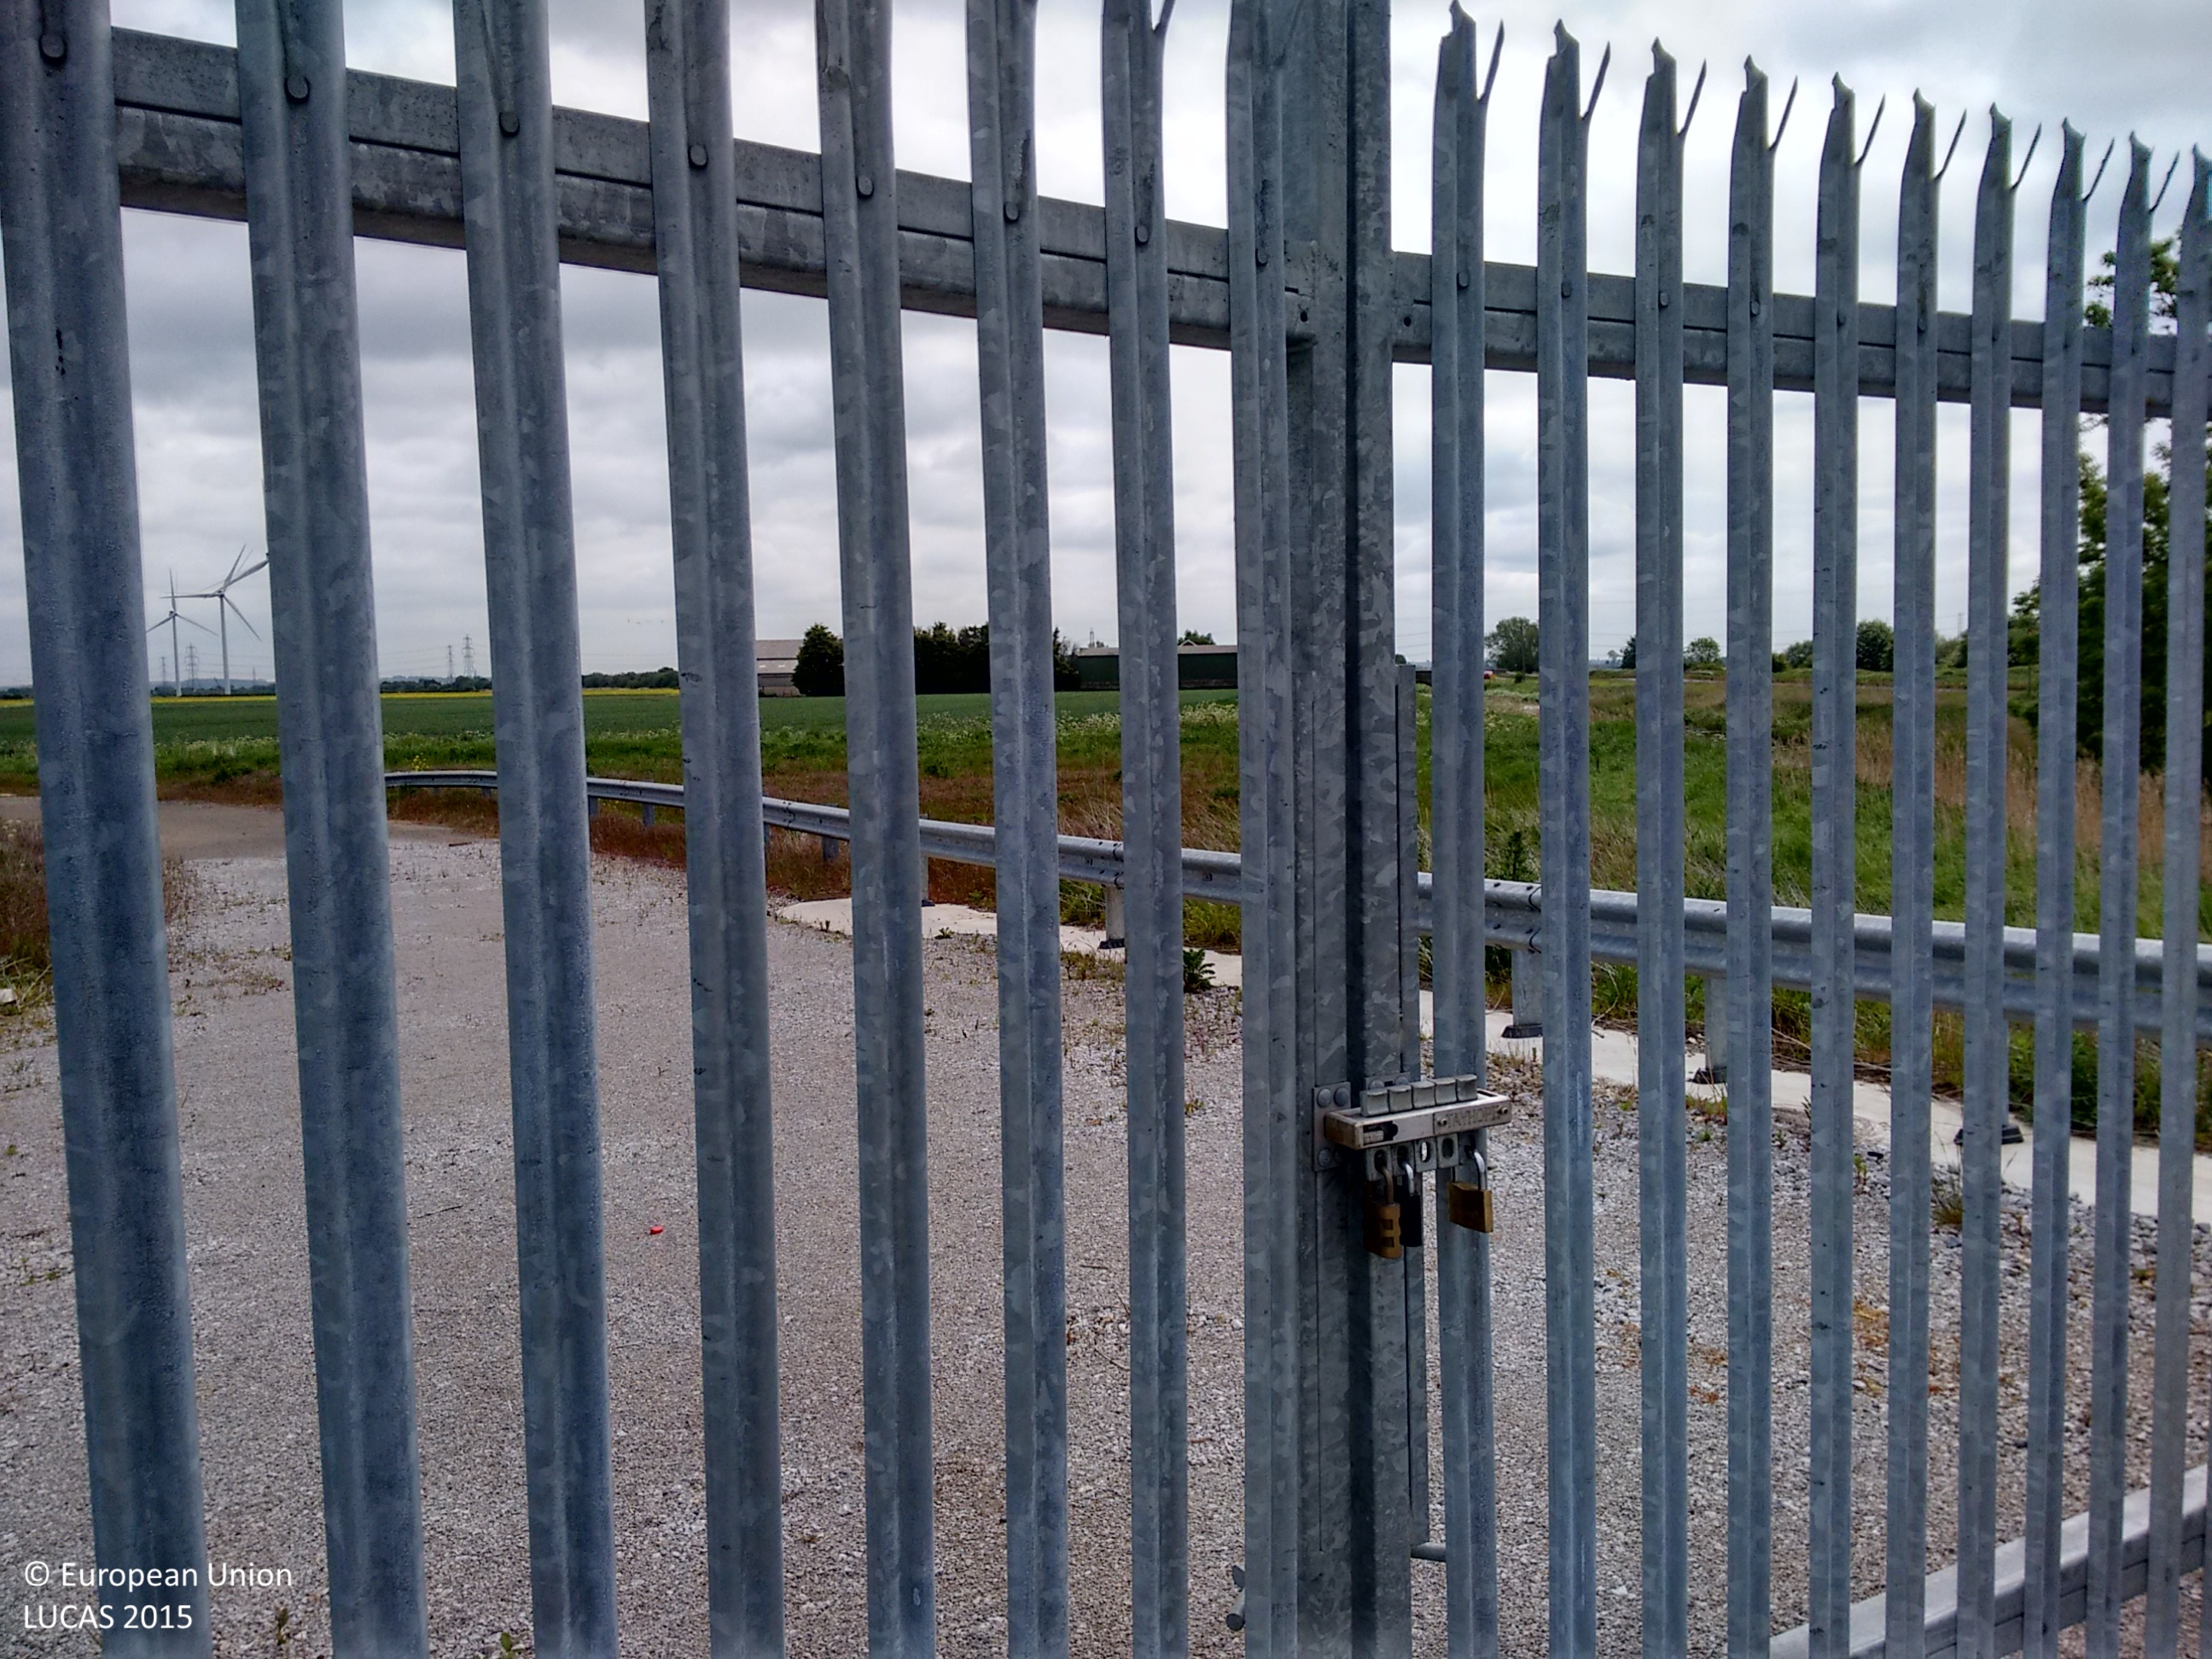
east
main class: Cropland
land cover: Permanent crops (only in case pi)
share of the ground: > 75 %
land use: Agriculture (excluding fallow land and kitchen gardens)
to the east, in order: Permanent crops (only in case pi); Grass margins; Ditches and canals; Grass margins; Permanent crops (only in case pi)
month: May
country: GB
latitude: 53.5904
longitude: -0.7820
